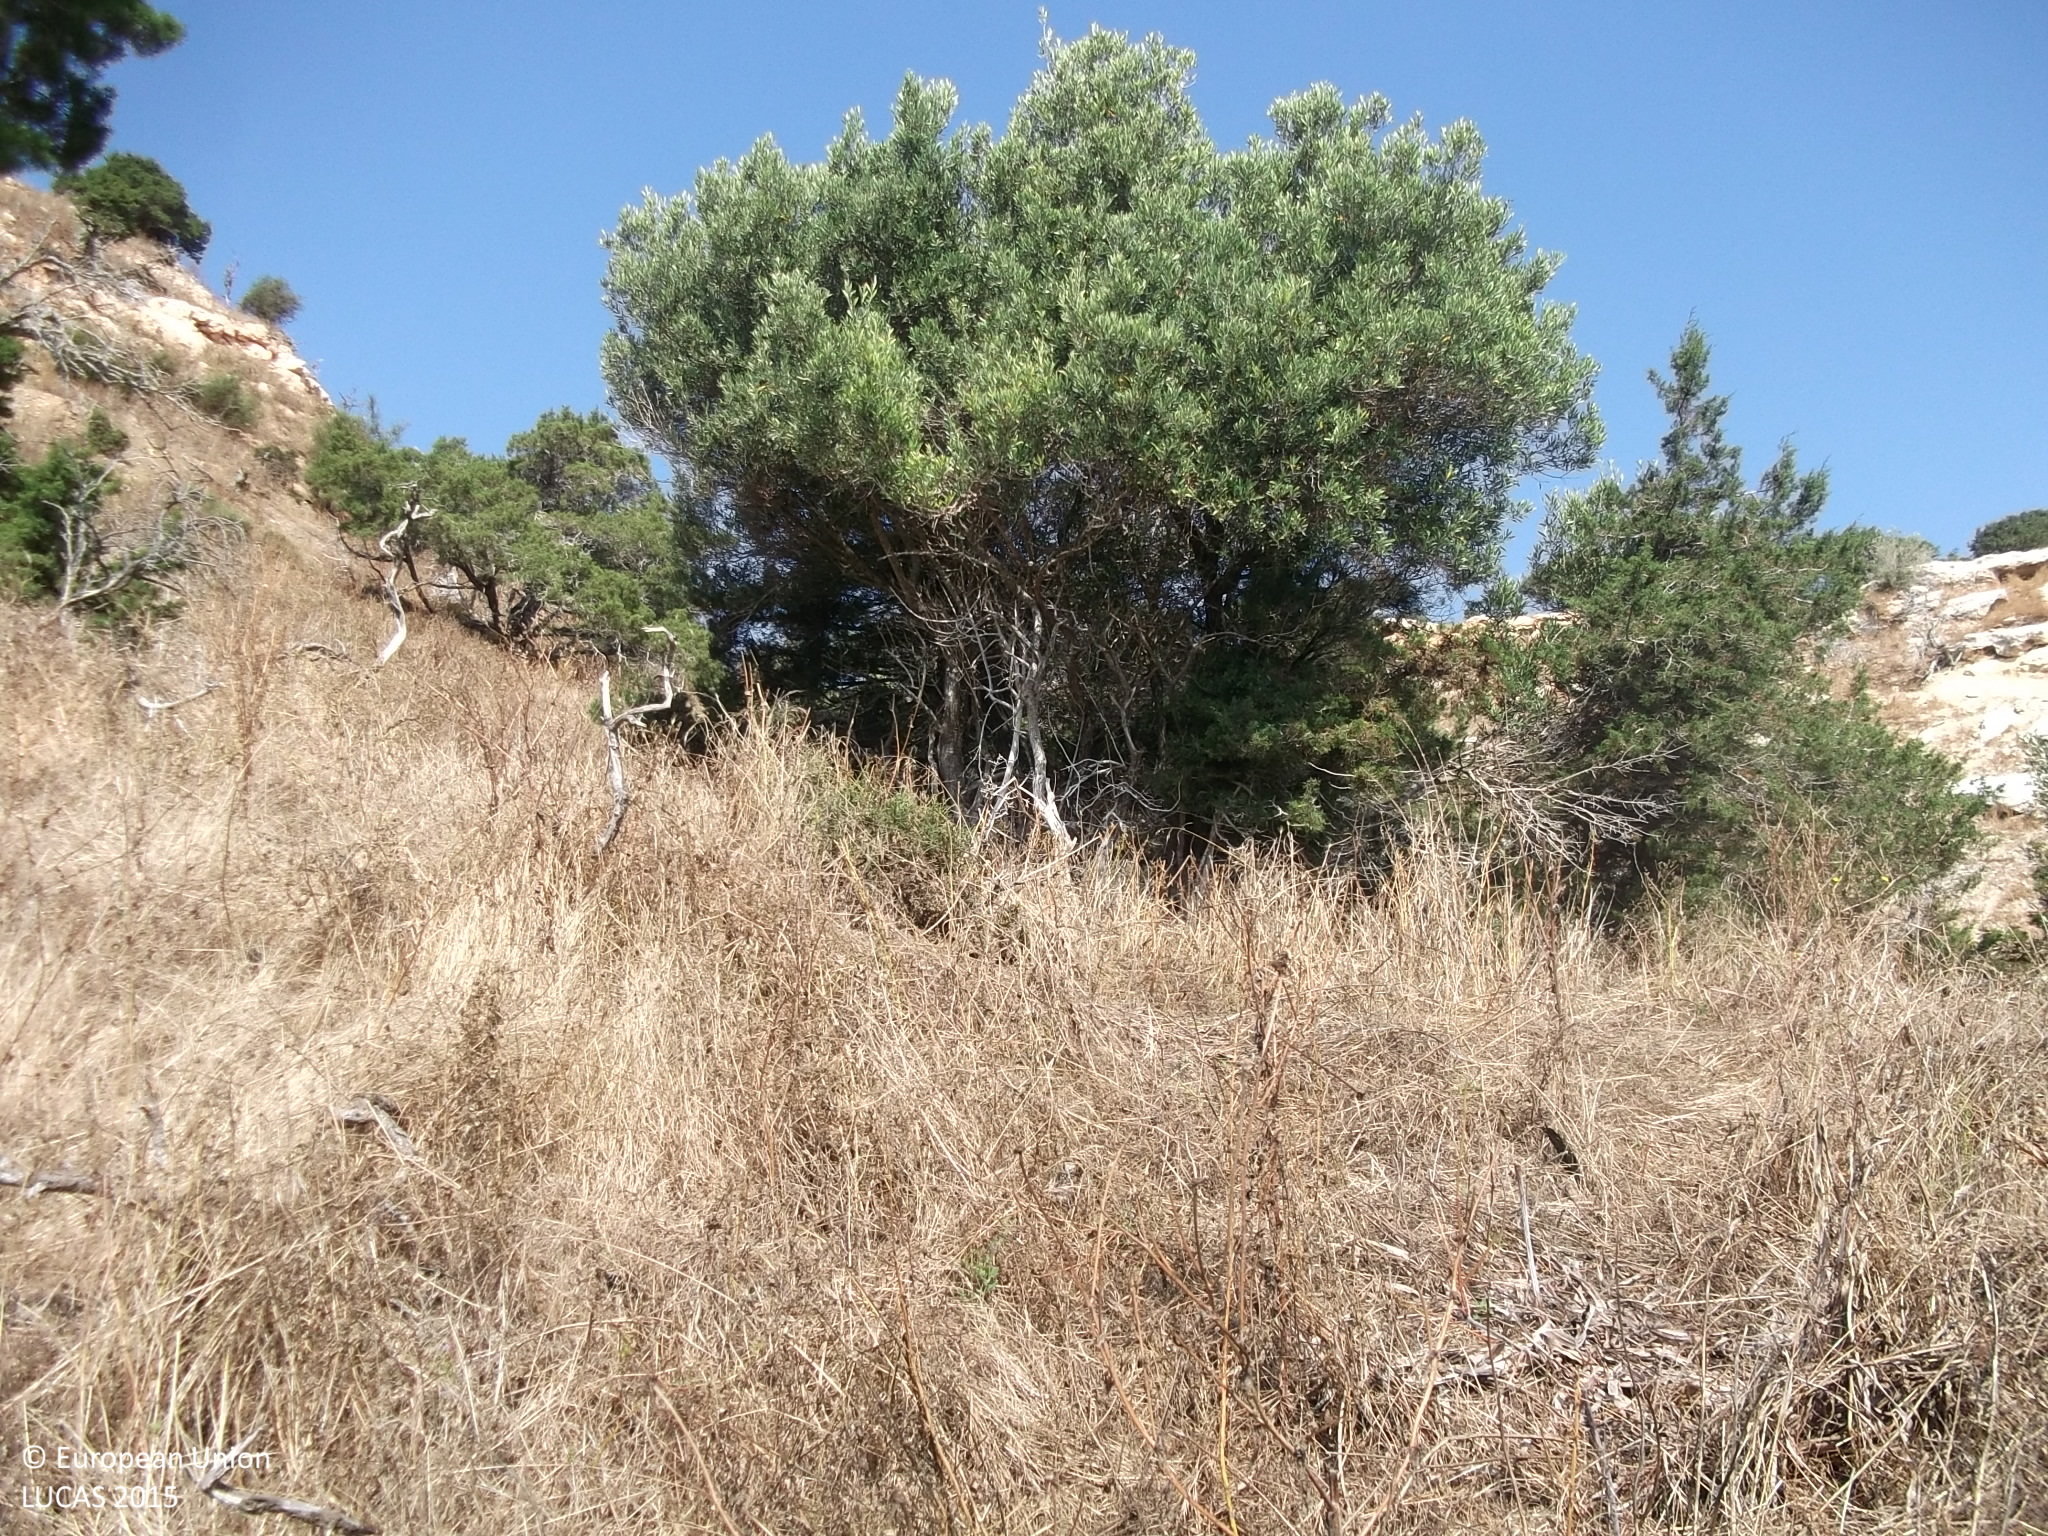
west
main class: Woodland
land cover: Other mixed woodland
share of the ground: 50 - 75 %
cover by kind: herbaceous plants 50 %, coniferous forest trees 30 %, broadleaved forest trees 20 %
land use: Agriculture (excluding fallow land and kitchen gardens)
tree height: < 5 m
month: May
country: CY
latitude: 35.0837
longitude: 32.2944
